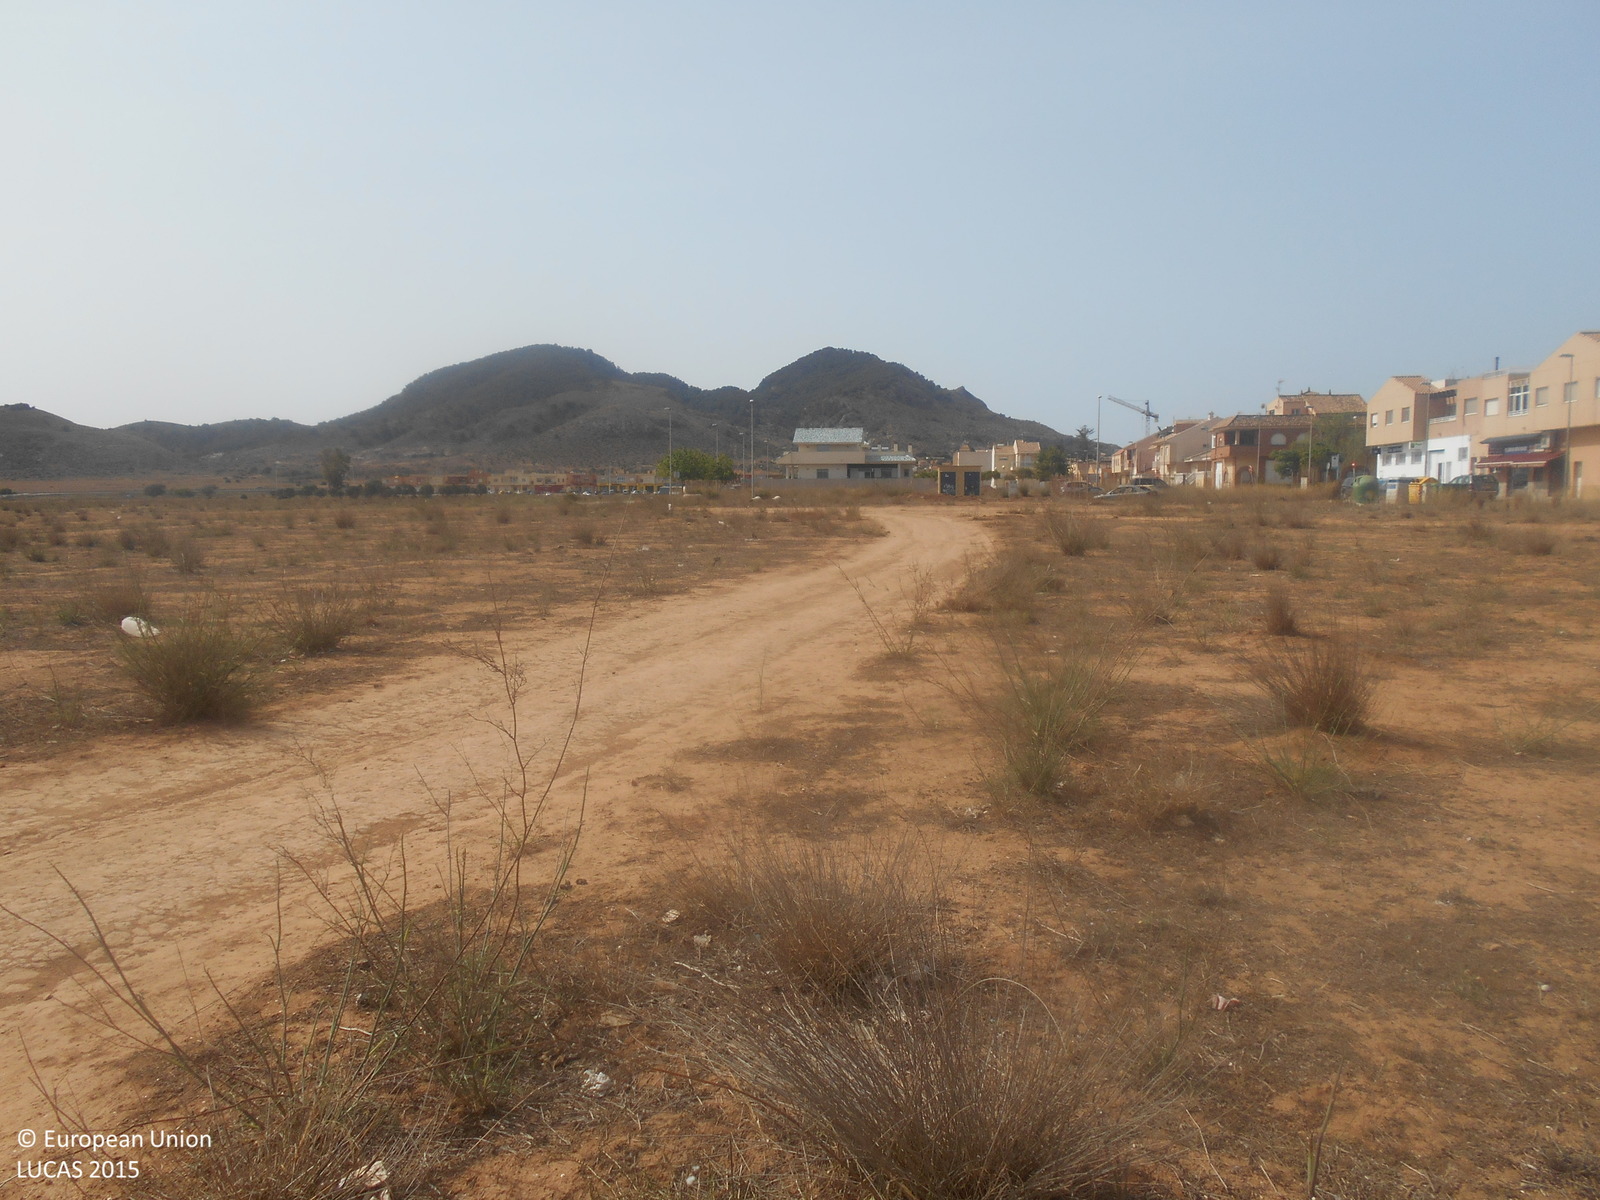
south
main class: Shrubland
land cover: Shrubland without tree cover
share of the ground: 10 - 25 %
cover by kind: unconsolidated bare surface 80 %, shrubs 10 %, herbaceous plants 10 %
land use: Semi-natural and natural areas not in use
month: May
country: ES
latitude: 37.6269
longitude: -0.7762
